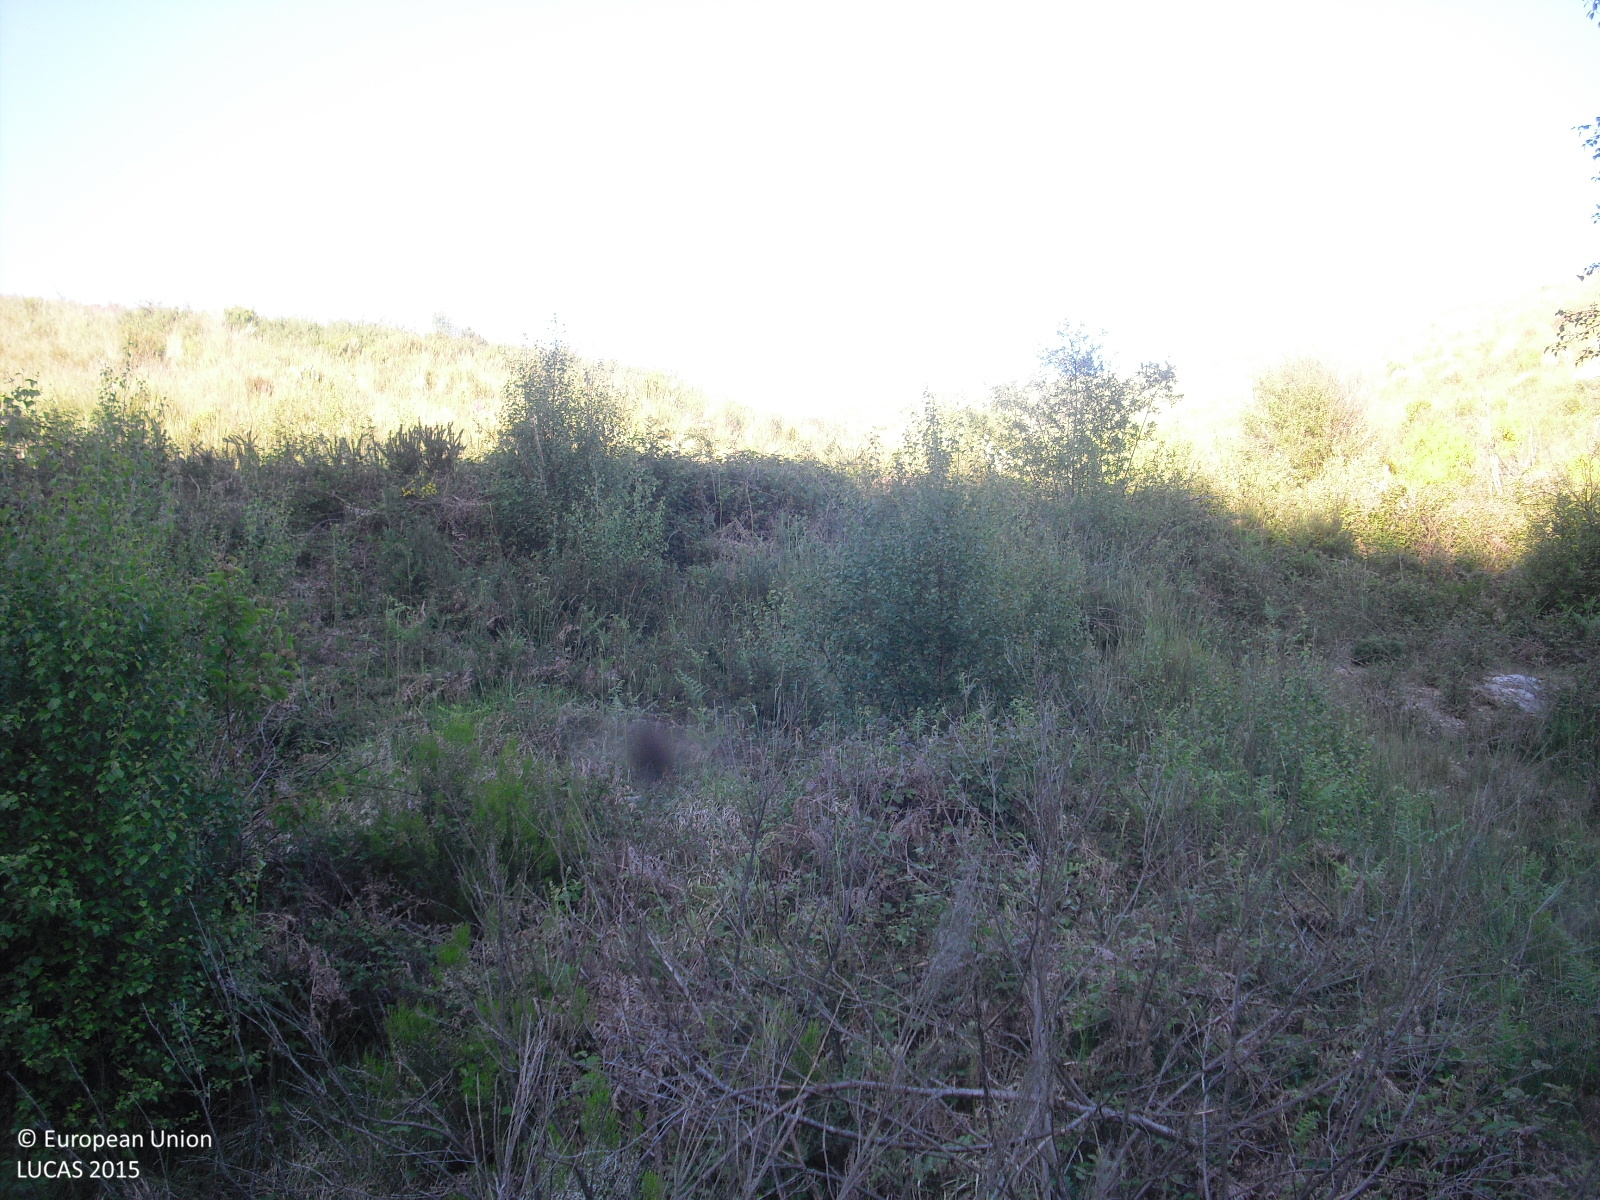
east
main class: Shrubland
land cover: Shrubland with sparse tree cover
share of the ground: > 75 %
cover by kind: shrubs 80 %, herbaceous plants 15 %, broadleaved forest trees 5 %
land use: Forestry
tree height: < 5 m
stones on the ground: 25 - 50 %
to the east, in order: Shrubland with sparse tree cover; Rivers and streams; Shrubland without tree cover; Shrubland with sparse tree cover; Ditches and canals; Shruby margins; Tracks; Shrubland with sparse tree cover; Rivers and streams; Shrubland with sparse tree cover
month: May
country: ES
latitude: 42.0249
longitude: -7.3663
